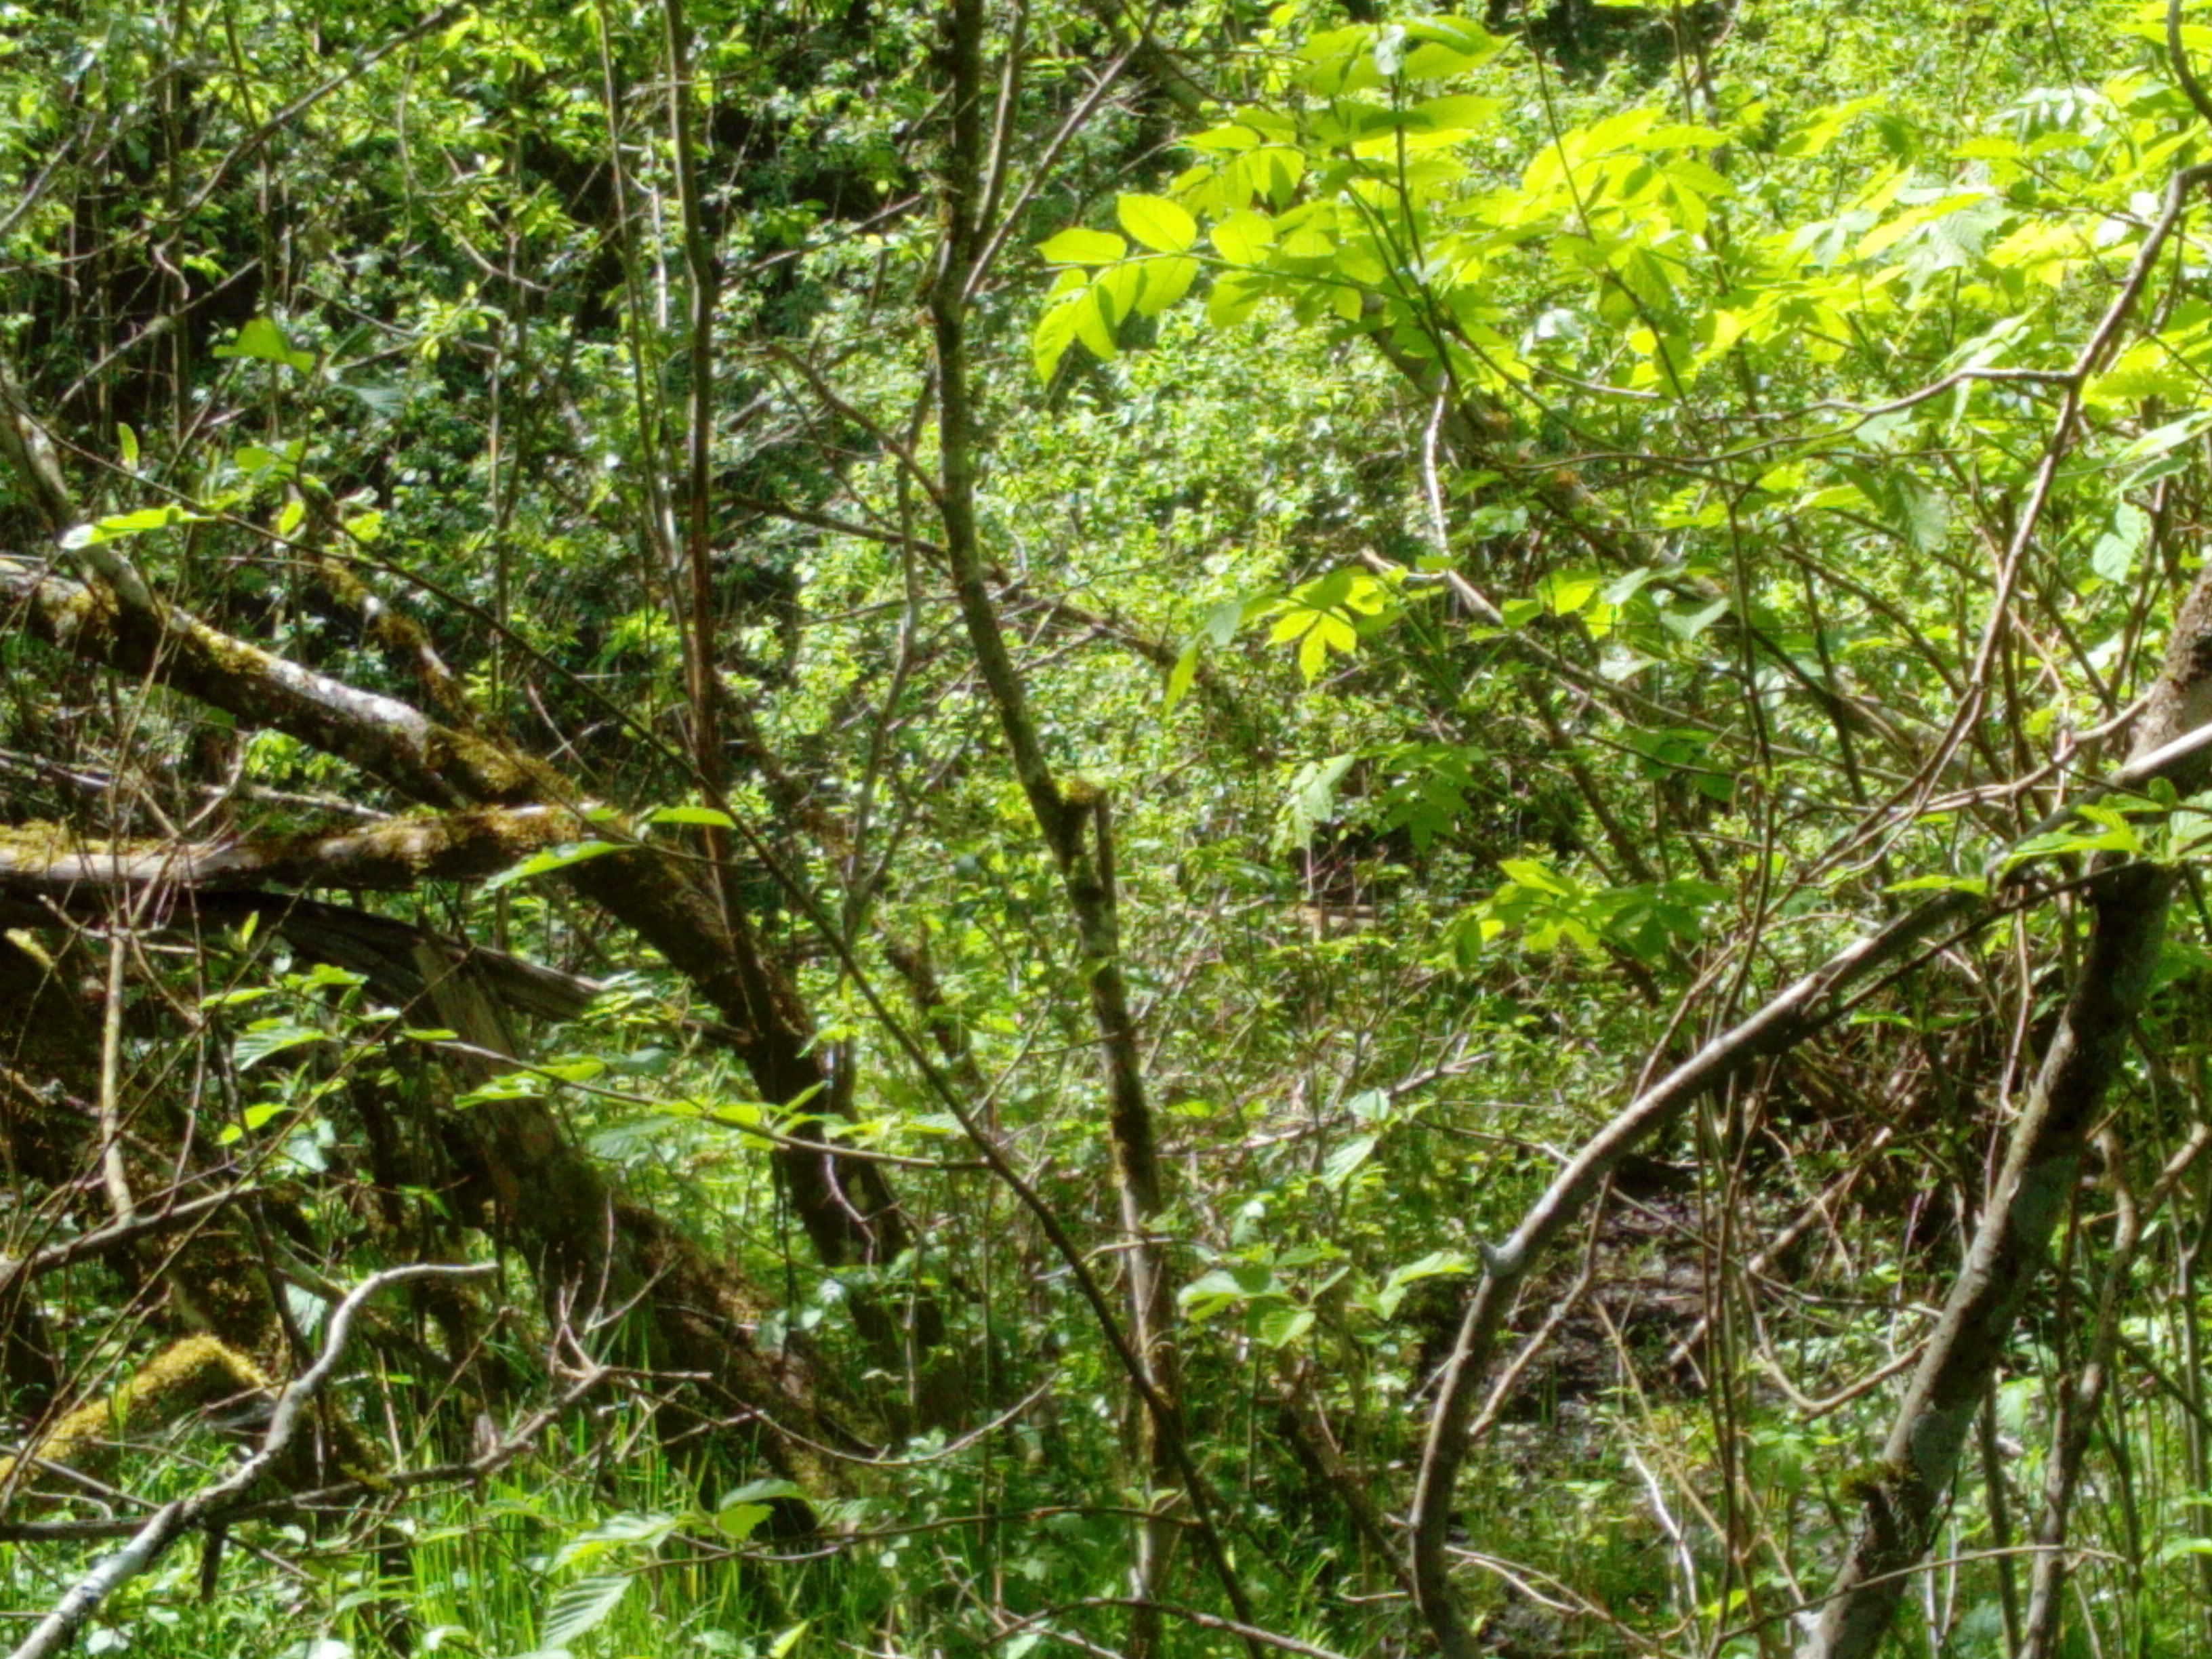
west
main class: Woodland
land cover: Spruce dominated mixed woodland
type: hemiboreal forest and nemoral coniferous forest and mixed broadleaved-coniferous forest
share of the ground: > 75 %
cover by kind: broadleaved forest trees 60 %, coniferous forest trees 40 %
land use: Forestry
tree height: > 5 m
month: May
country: LV
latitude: 56.4843
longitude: 22.3145
